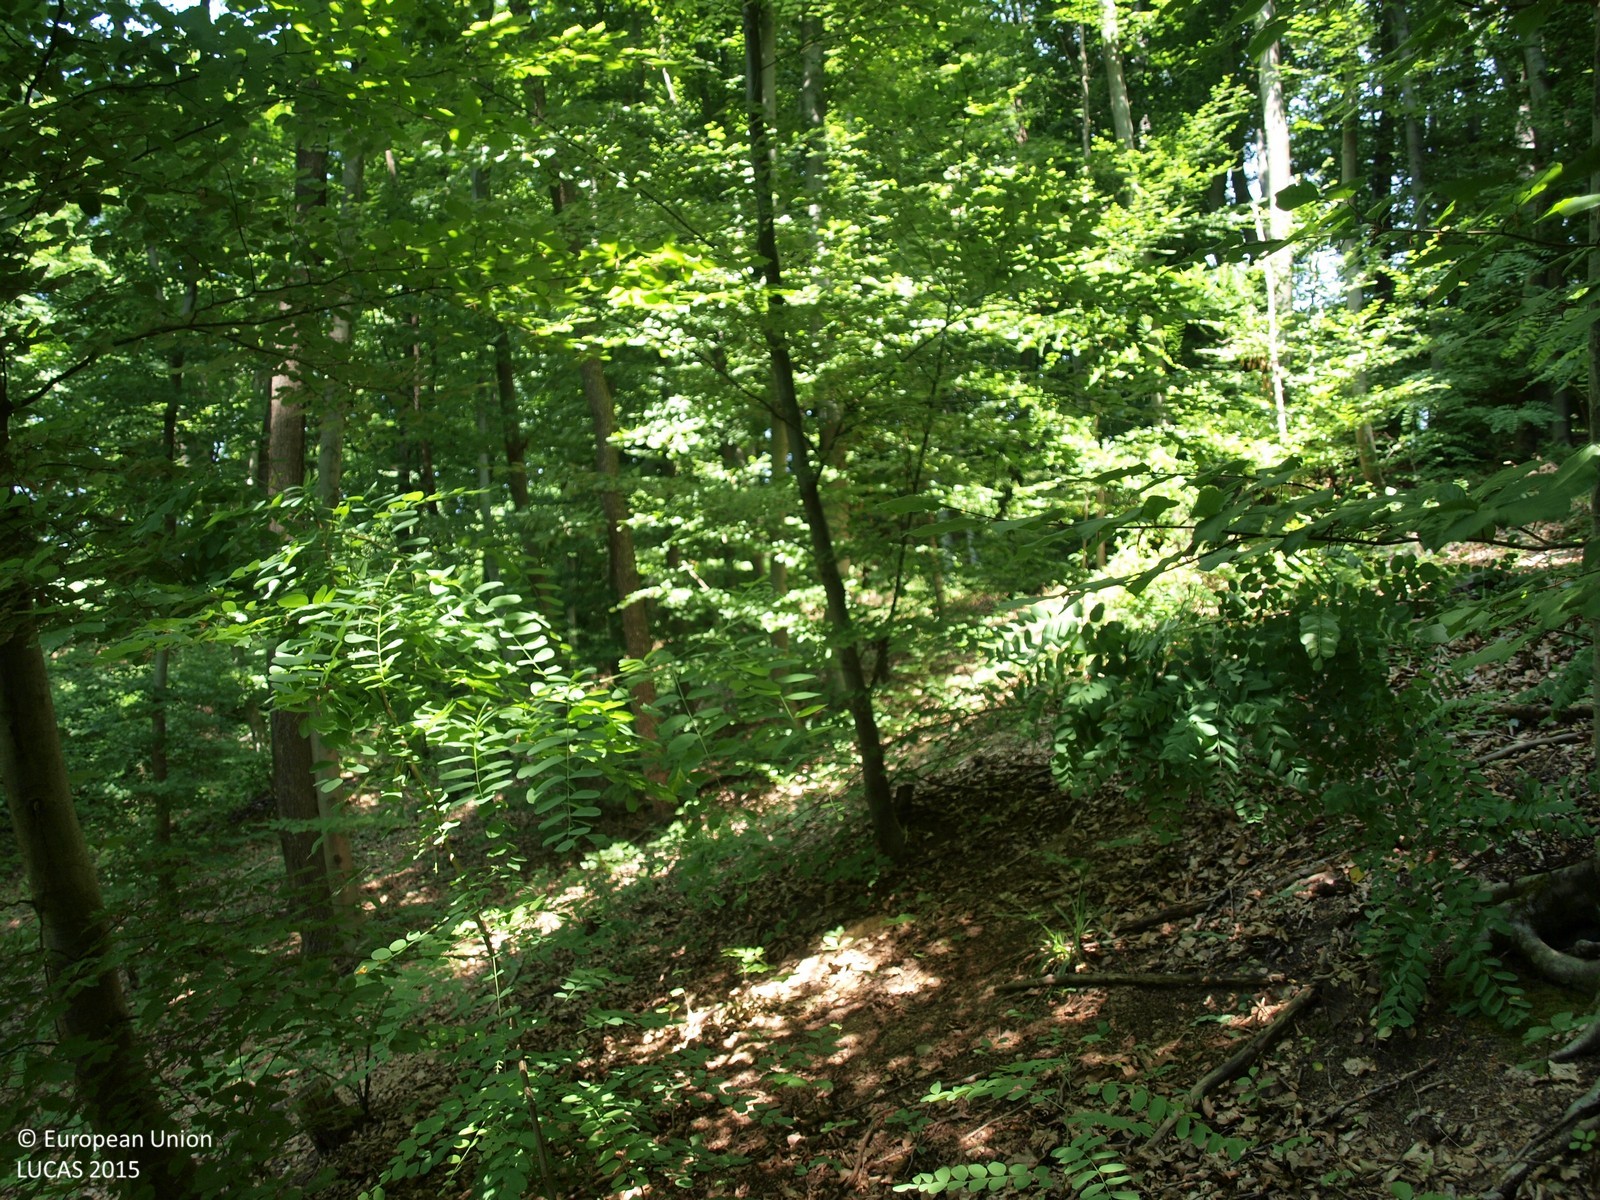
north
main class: Woodland
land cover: Broadleaved woodland
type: beech forest
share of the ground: > 75 %
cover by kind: broadleaved forest trees 100 %
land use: Forestry
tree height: > 5 m
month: July
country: HR
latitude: 45.7455
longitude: 15.7428
